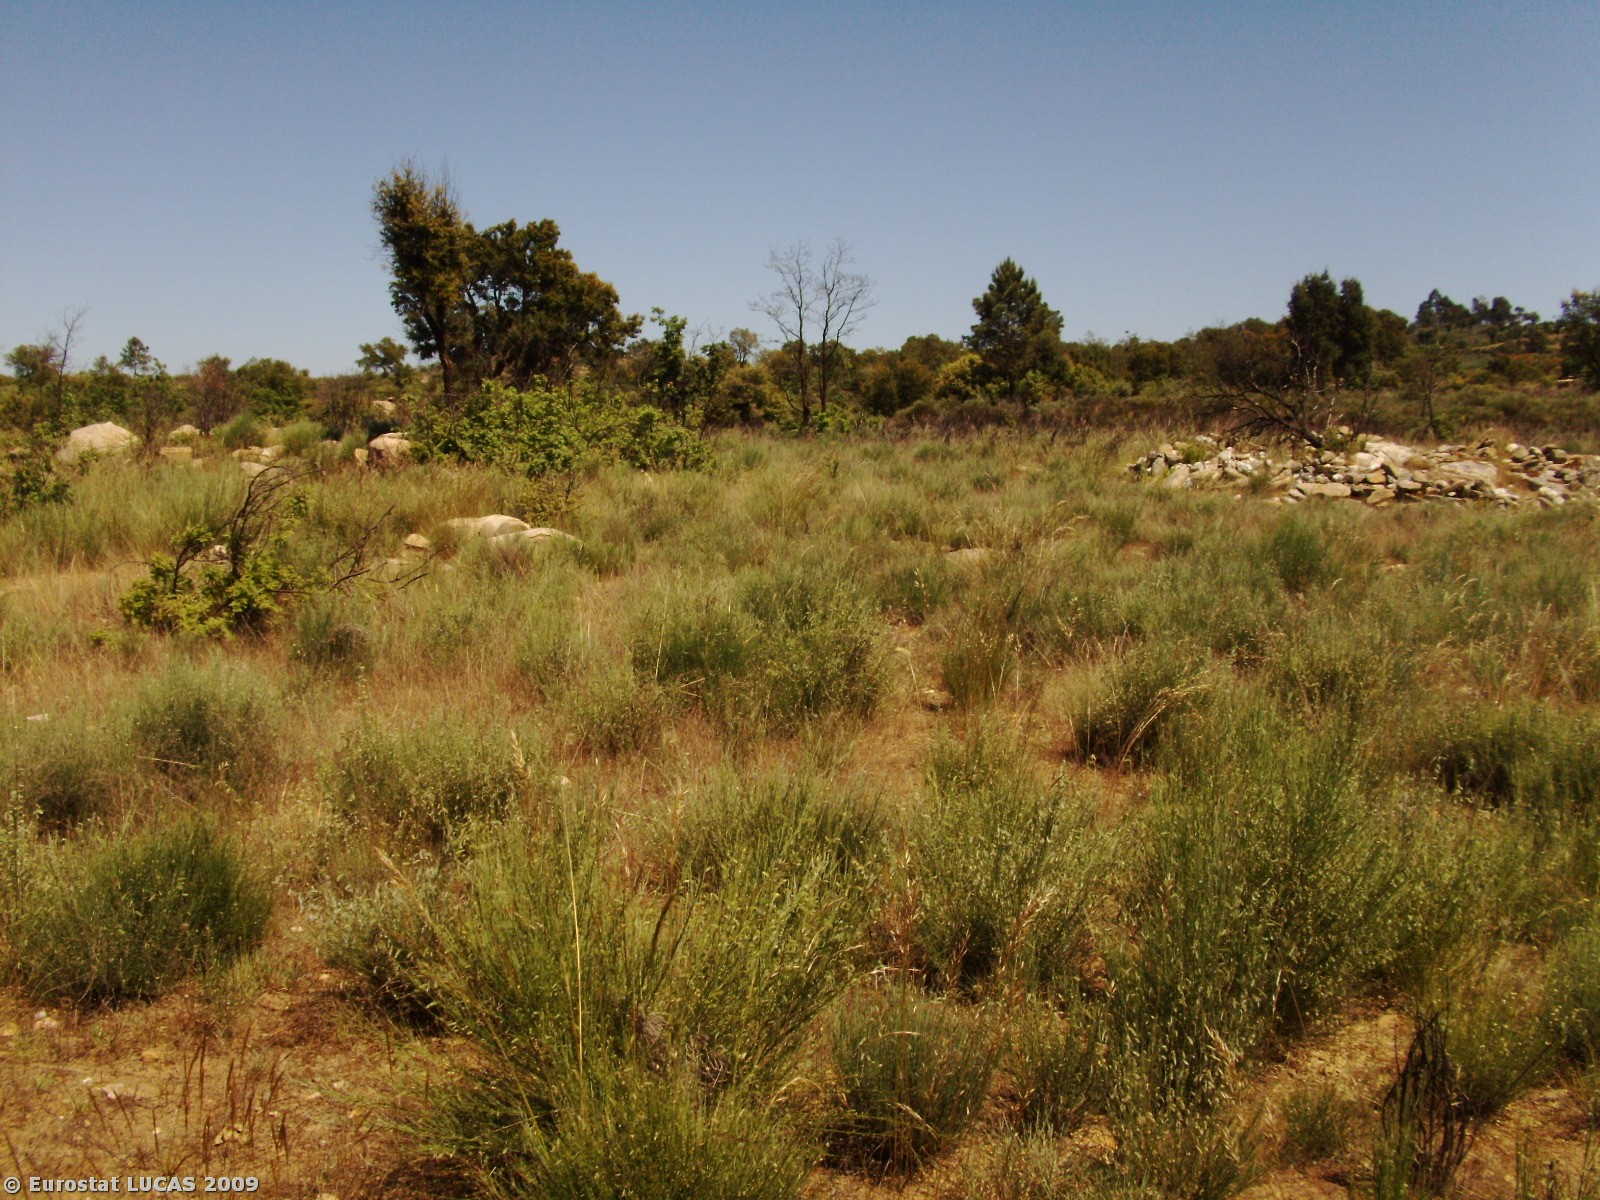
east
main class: Woodland
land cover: Broadleaved woodland
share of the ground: 25 - 50 %
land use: Forestry
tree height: > 5 m
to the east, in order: Broadleaved woodland; Dry stone walls; Shrubland with sparse tree cover; Dry stone walls; Spontaneously vegetated surfaces; Dry stone walls; Shrubland with sparse tree cover; Dry stone walls; Shrubland with sparse tree cover; Maize; Dry stone walls
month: May
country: PT
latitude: 40.8462
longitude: -7.1523
